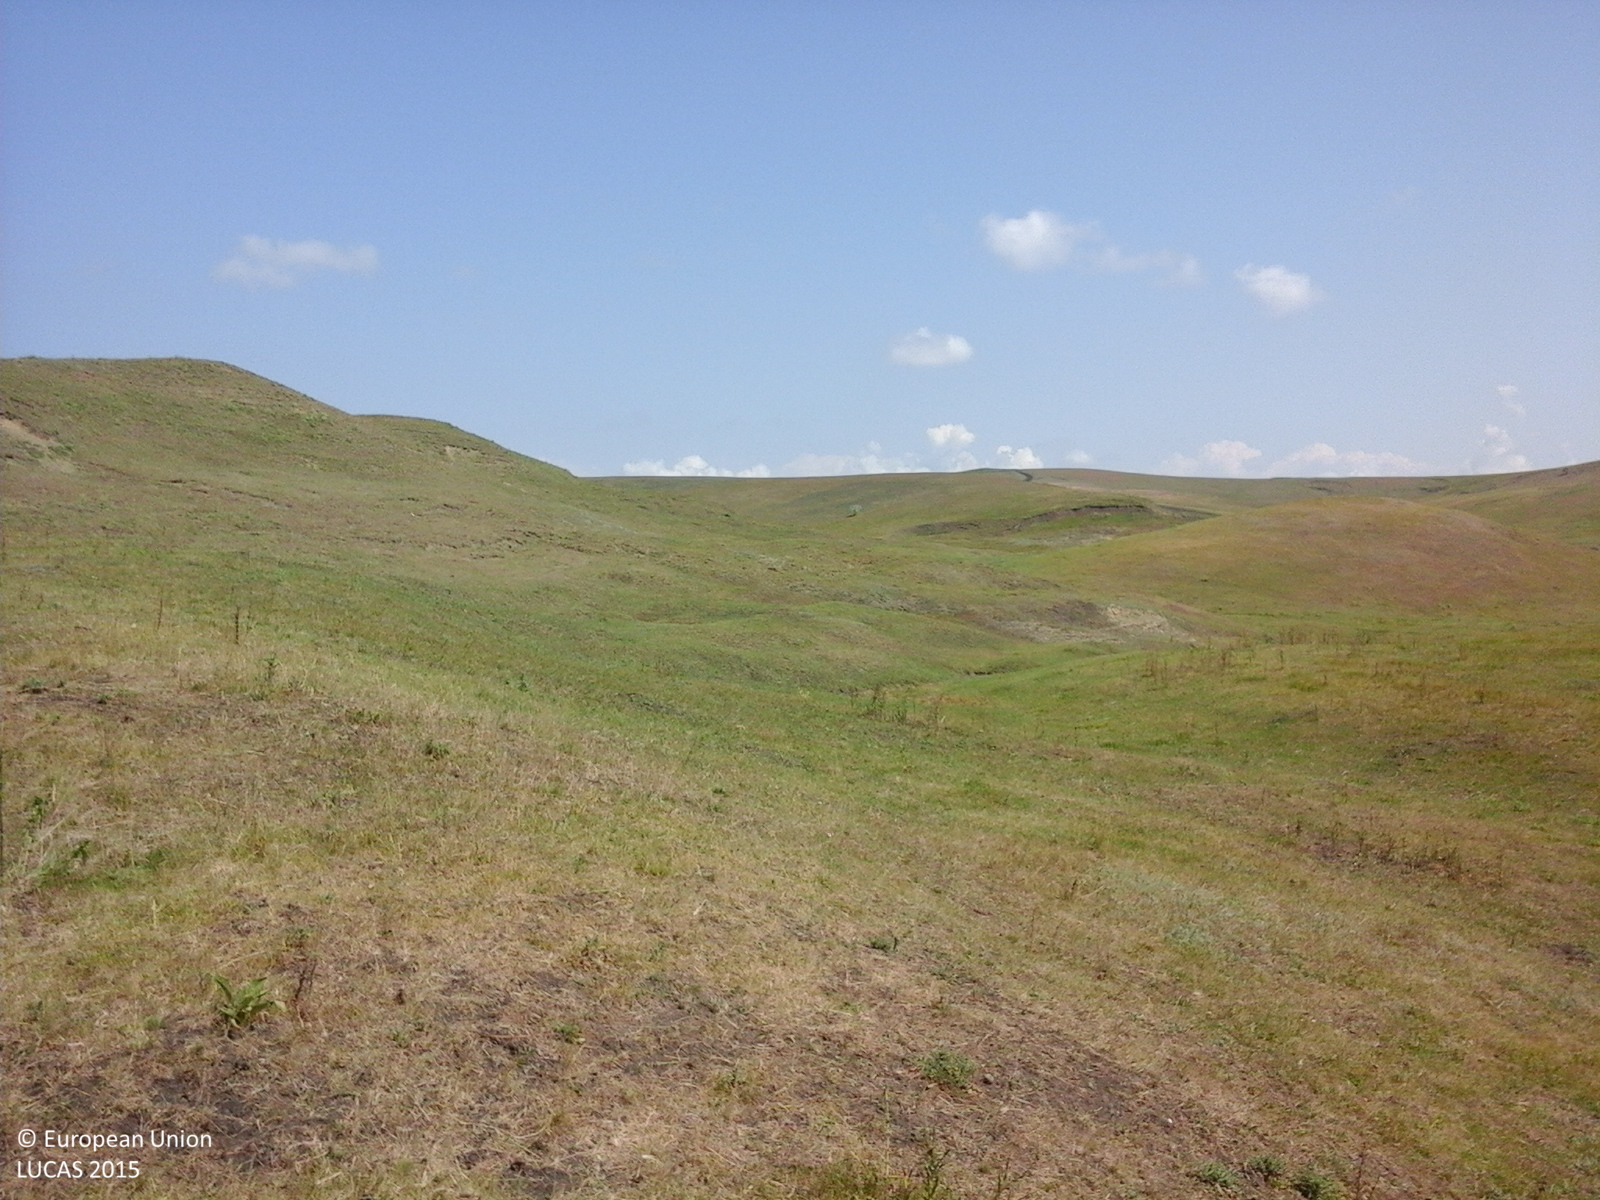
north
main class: Grassland
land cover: Grassland without tree/shrub cover
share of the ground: > 75 %
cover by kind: herbaceous plants 90 %, unconsolidated bare surface 10 %
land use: Agriculture (excluding fallow land and kitchen gardens)
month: June
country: RO
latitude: 47.9461
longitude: 26.7131
